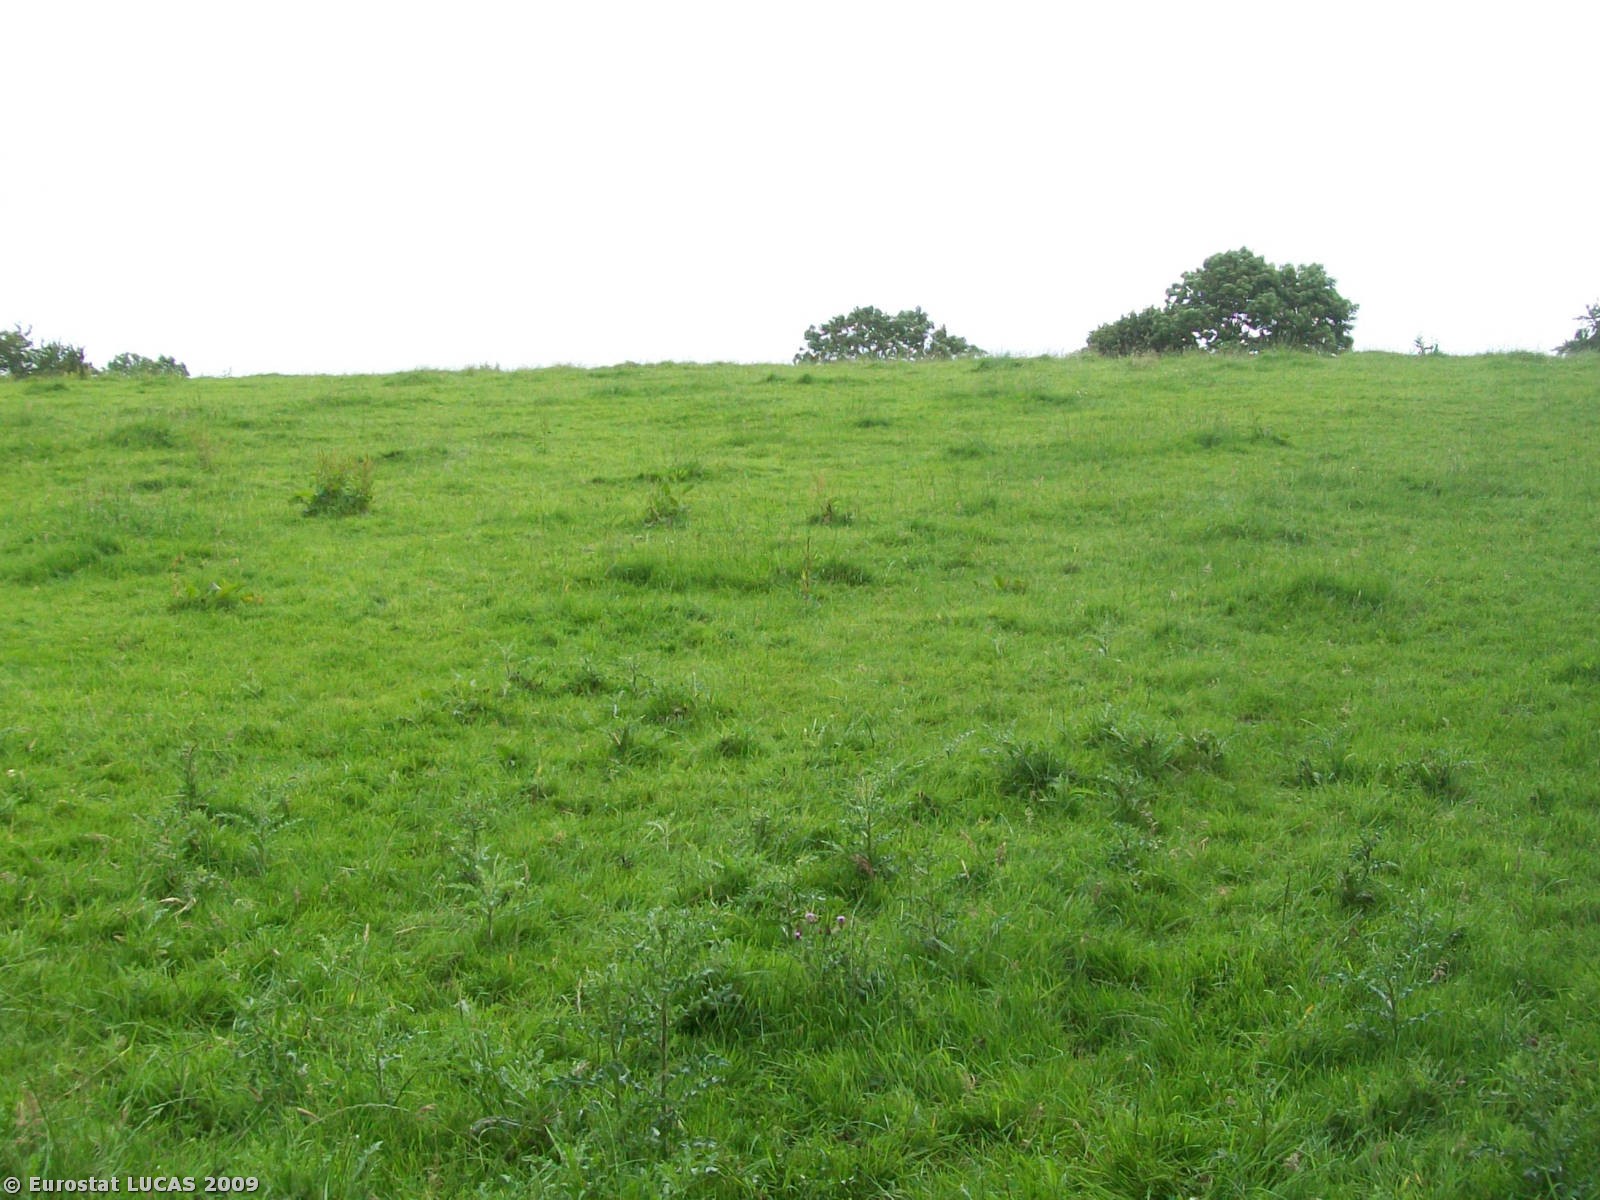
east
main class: Grassland
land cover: Grassland without tree/shrub cover
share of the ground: > 75 %
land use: Agriculture (excluding fallow land and kitchen gardens)
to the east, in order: Grassland without tree/shrub cover; Fences; Abandoned hedges; Grassland without tree/shrub cover; Fences; Managed hedges; Electric lines; Grass margins; Paved roads, cycling and walking lanes; Grass margins; Single bushes/trees; Abandoned hedges; Fences; Grassland without tree/shrub cover
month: July
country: GB
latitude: 55.1712
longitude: -6.3028
